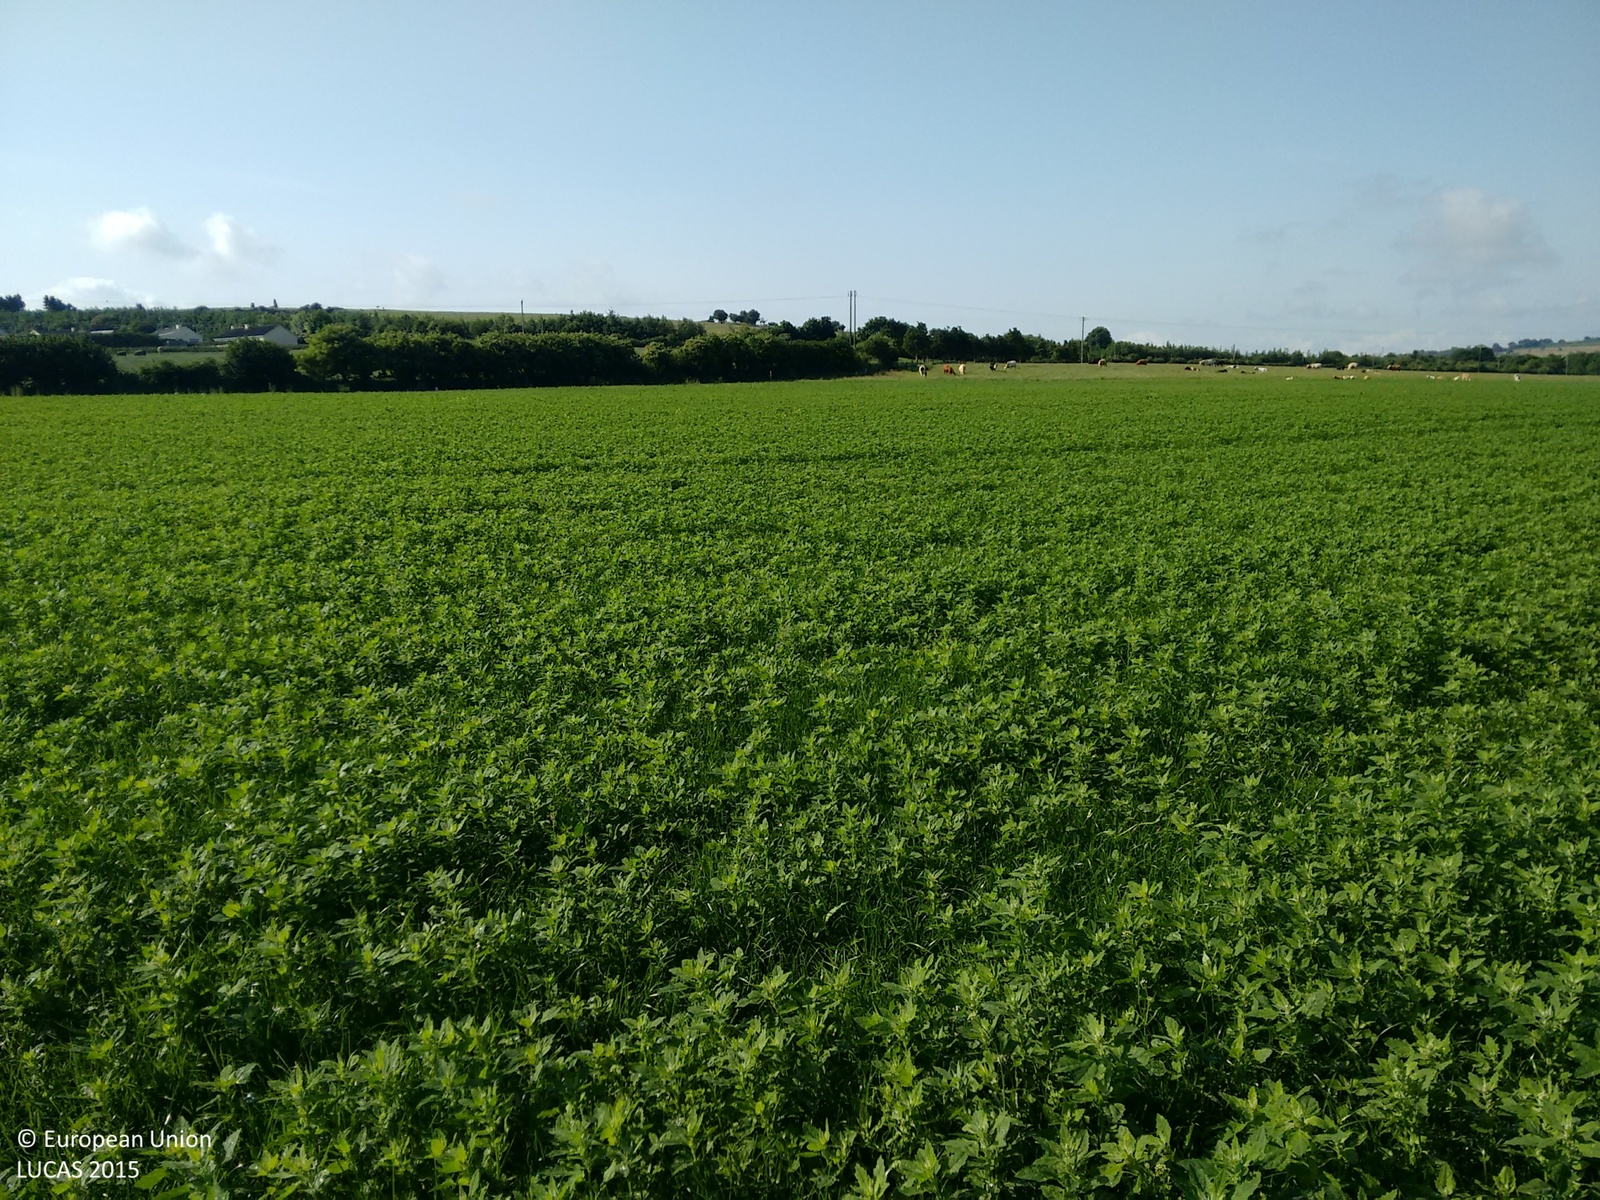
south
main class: Cropland
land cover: Temporary grasslands
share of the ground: > 75 %
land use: Agriculture (excluding fallow land and kitchen gardens)
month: July
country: IE
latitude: 52.5782
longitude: -7.7122
